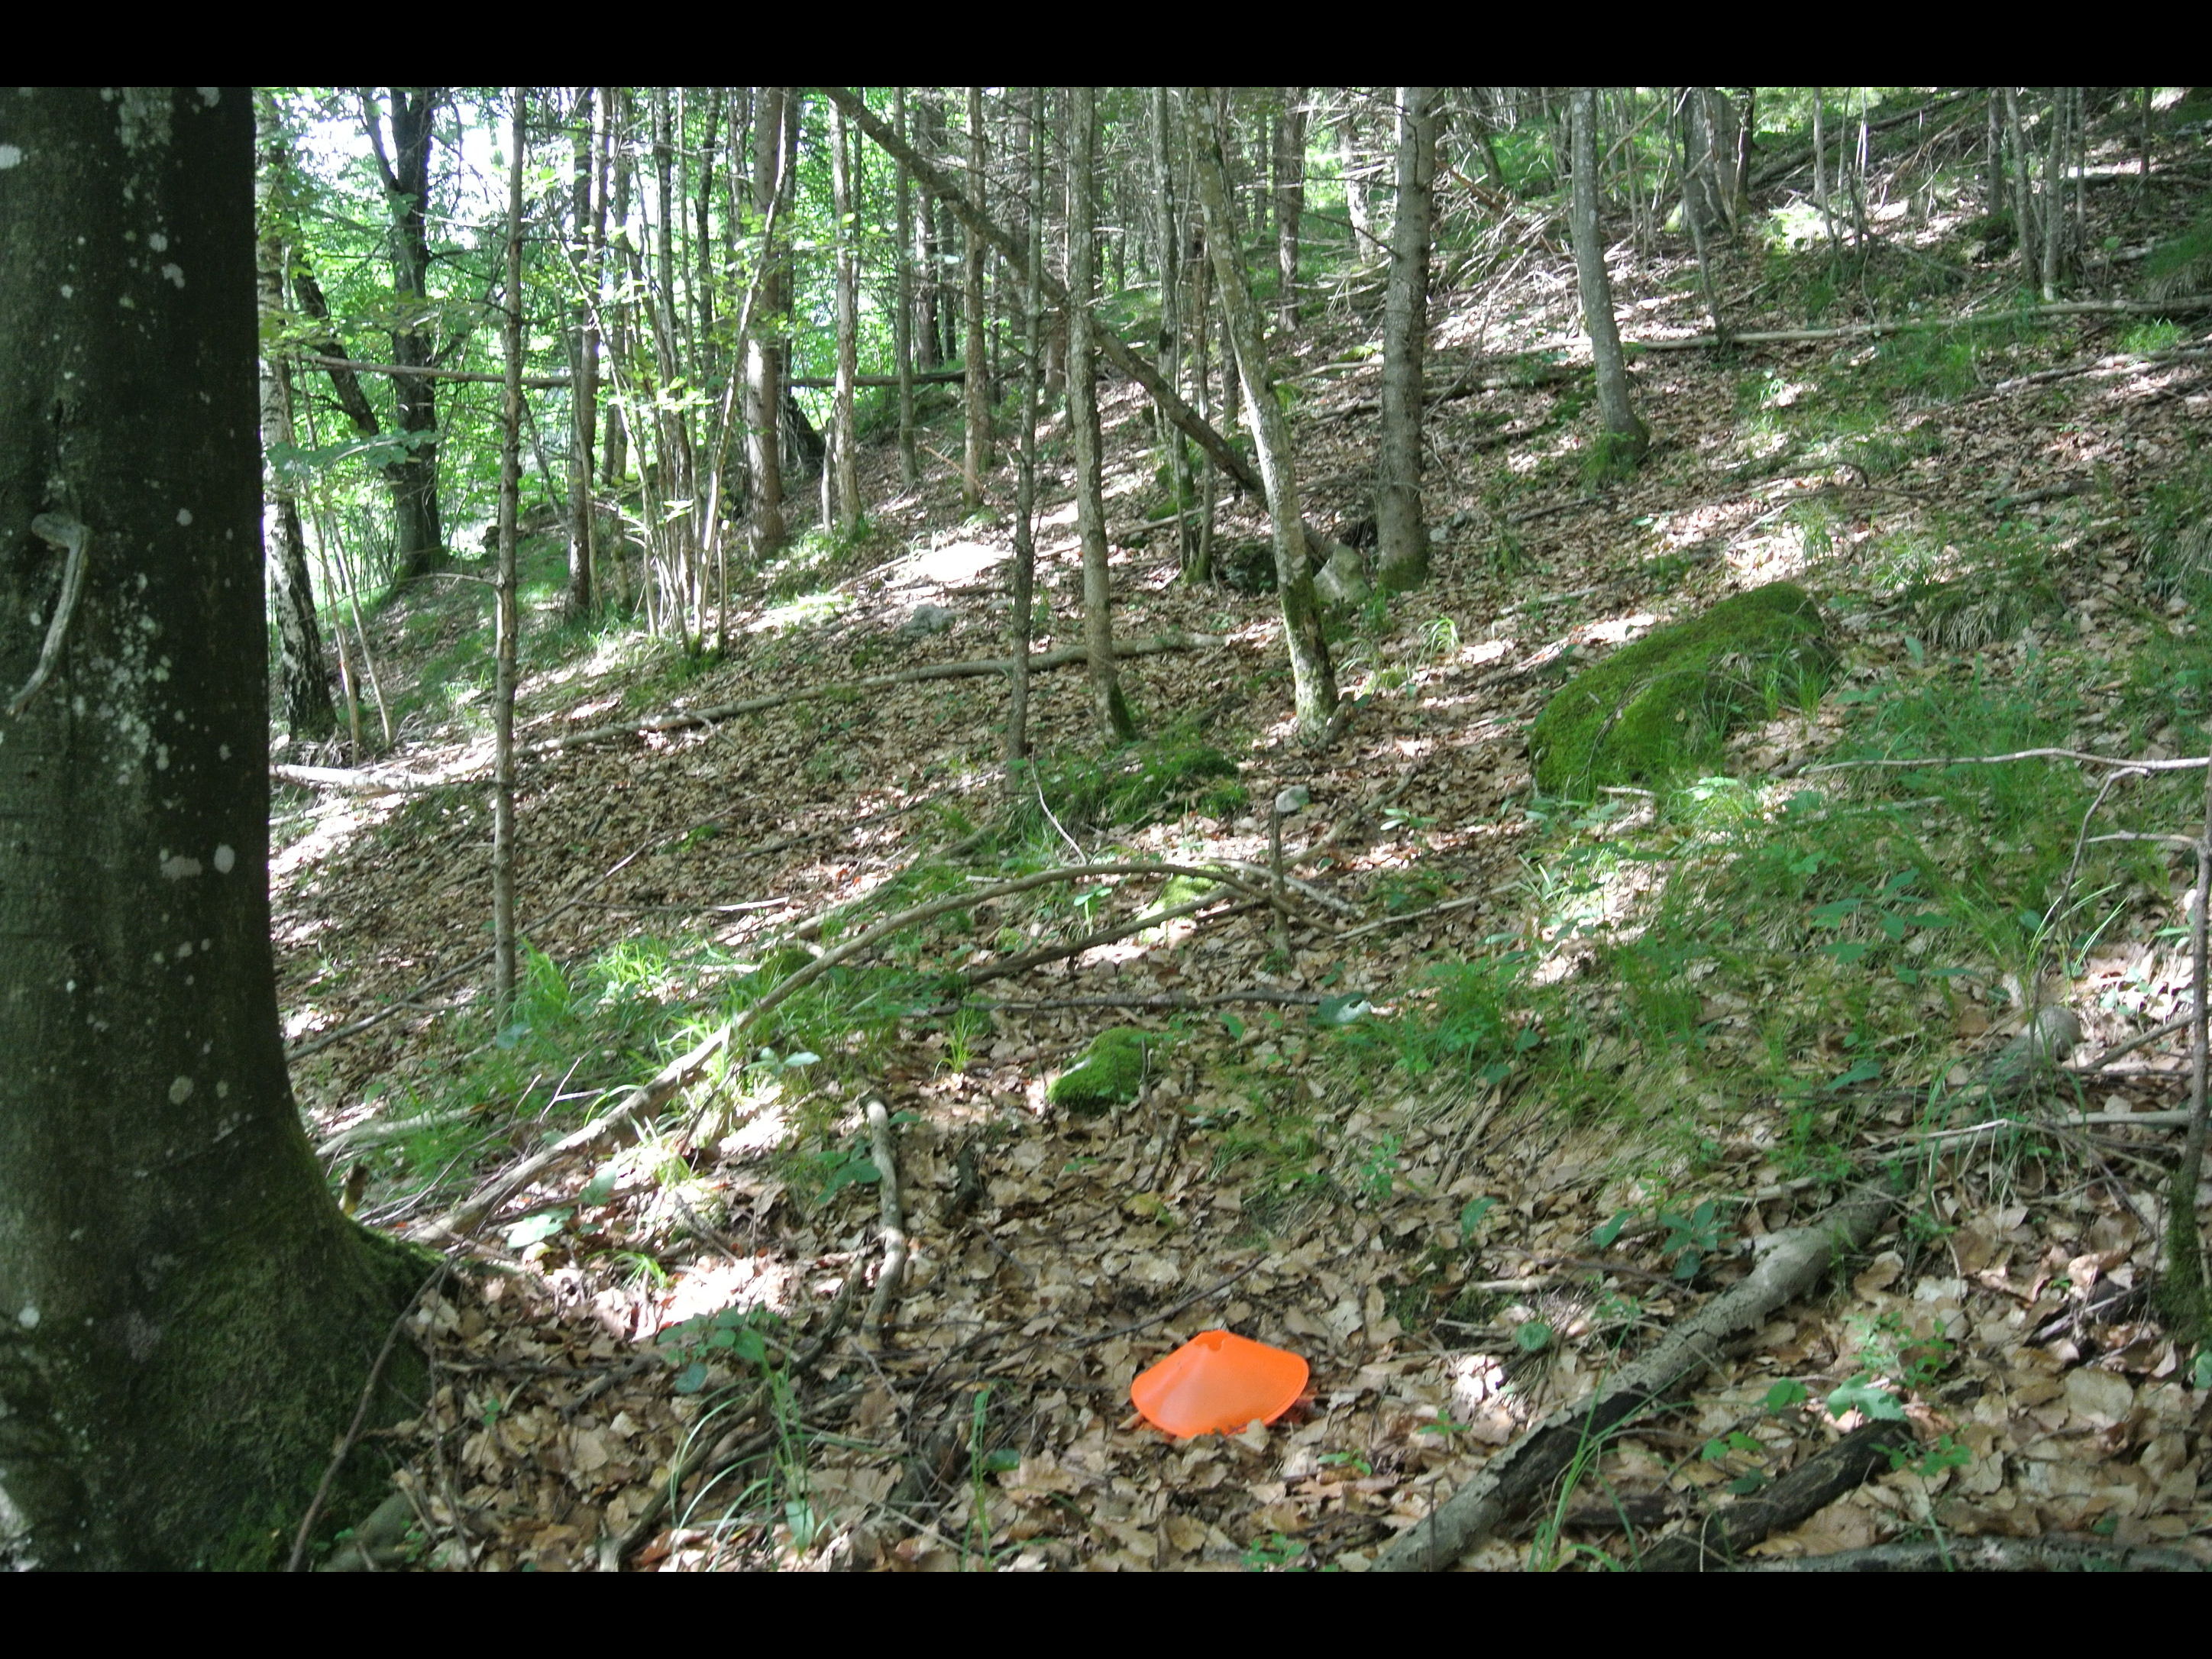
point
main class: Woodland
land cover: Spruce dominated mixed woodland
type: alpine coniferous forest
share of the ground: > 75 %
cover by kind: broadleaved forest trees 75 %, coniferous forest trees 25 %
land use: Forestry
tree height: > 5 m
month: June
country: AT
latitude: 47.9265
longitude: 15.4488
